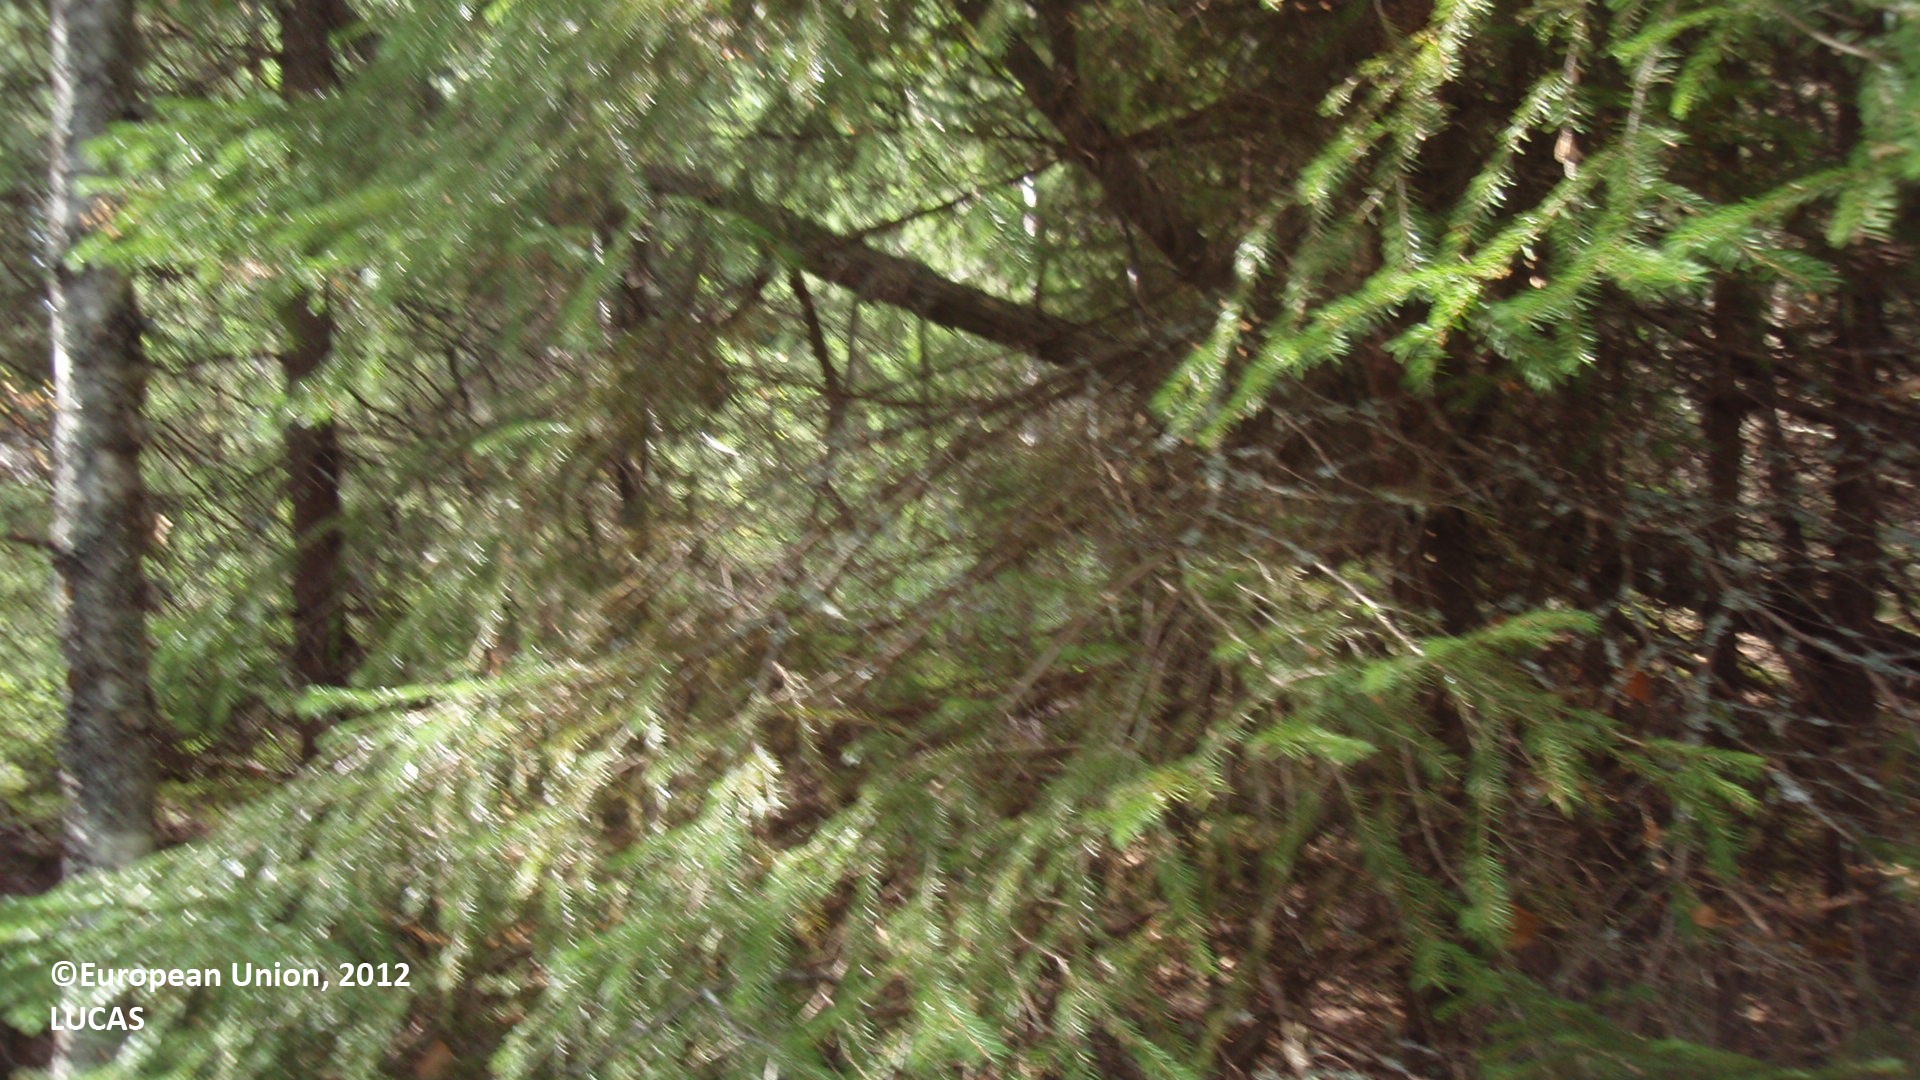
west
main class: Woodland
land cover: Spruce dominated mixed woodland
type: boreal forest
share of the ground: 50 - 75 %
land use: Forestry
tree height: > 5 m
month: August
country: FI
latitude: 60.8073
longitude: 27.2507
